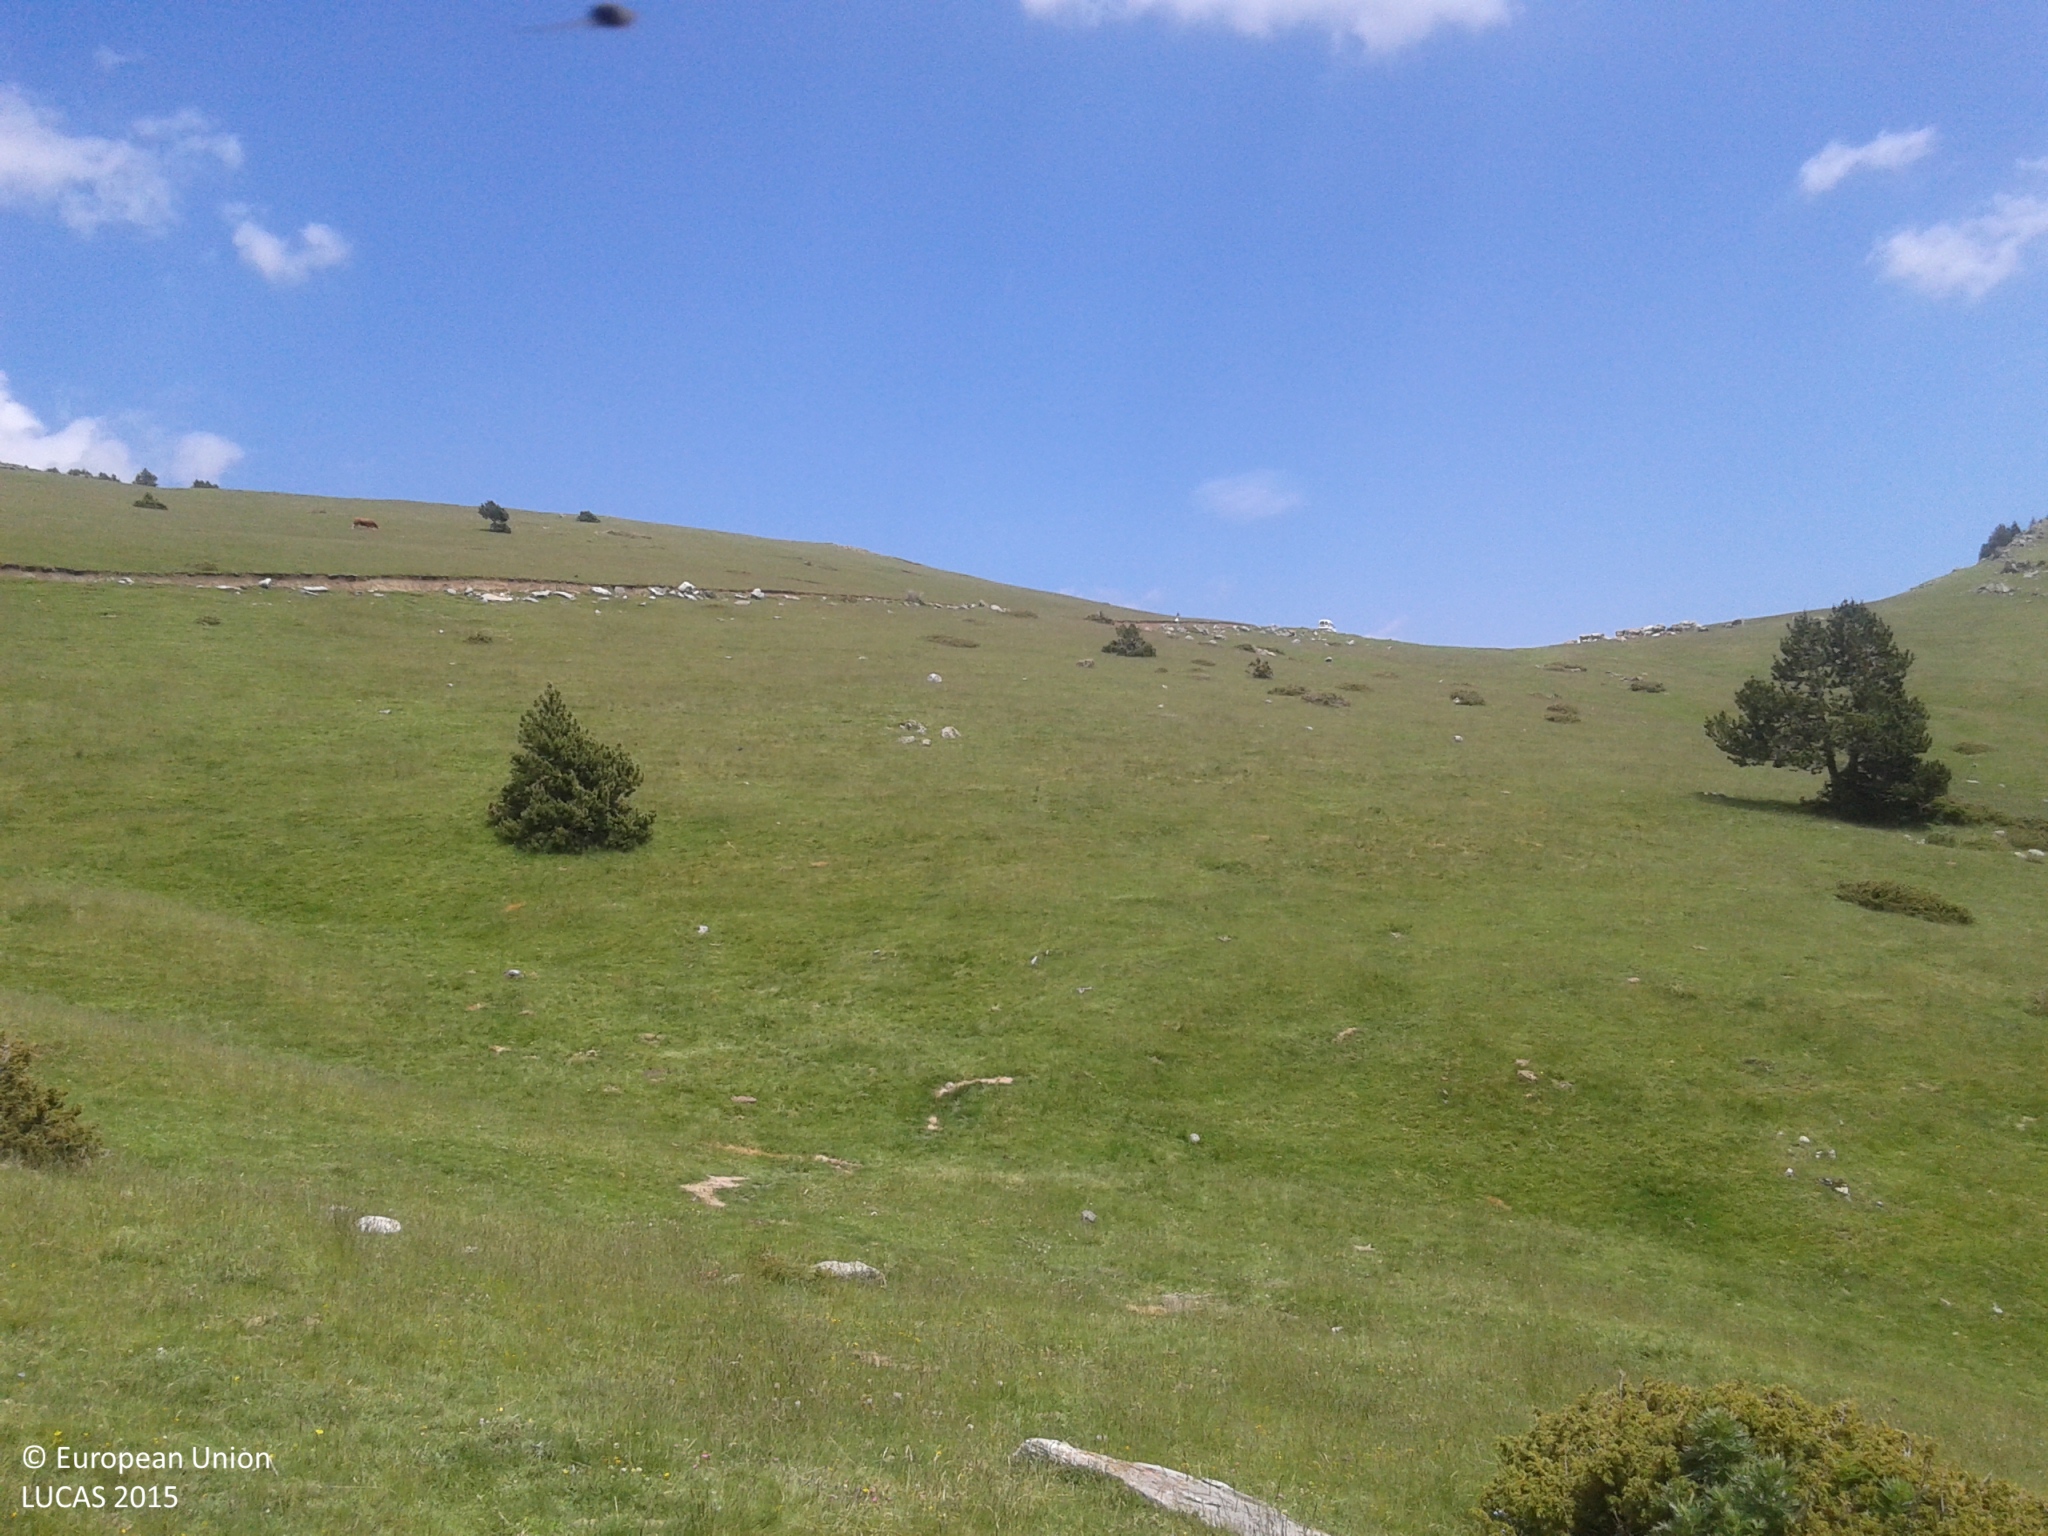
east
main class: Shrubland
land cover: Shrubland with sparse tree cover
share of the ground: > 75 %
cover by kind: herbaceous plants 85 %, shrubs 10 %, coniferous forest trees 5 %
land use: Agriculture (excluding fallow land and kitchen gardens)
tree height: > 5 m
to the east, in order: Shrubland with sparse tree cover; Grassland without tree/shrub cover; Tracks; Grassland without tree/shrub cover
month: June
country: ES
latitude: 42.4126
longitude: 1.5891
